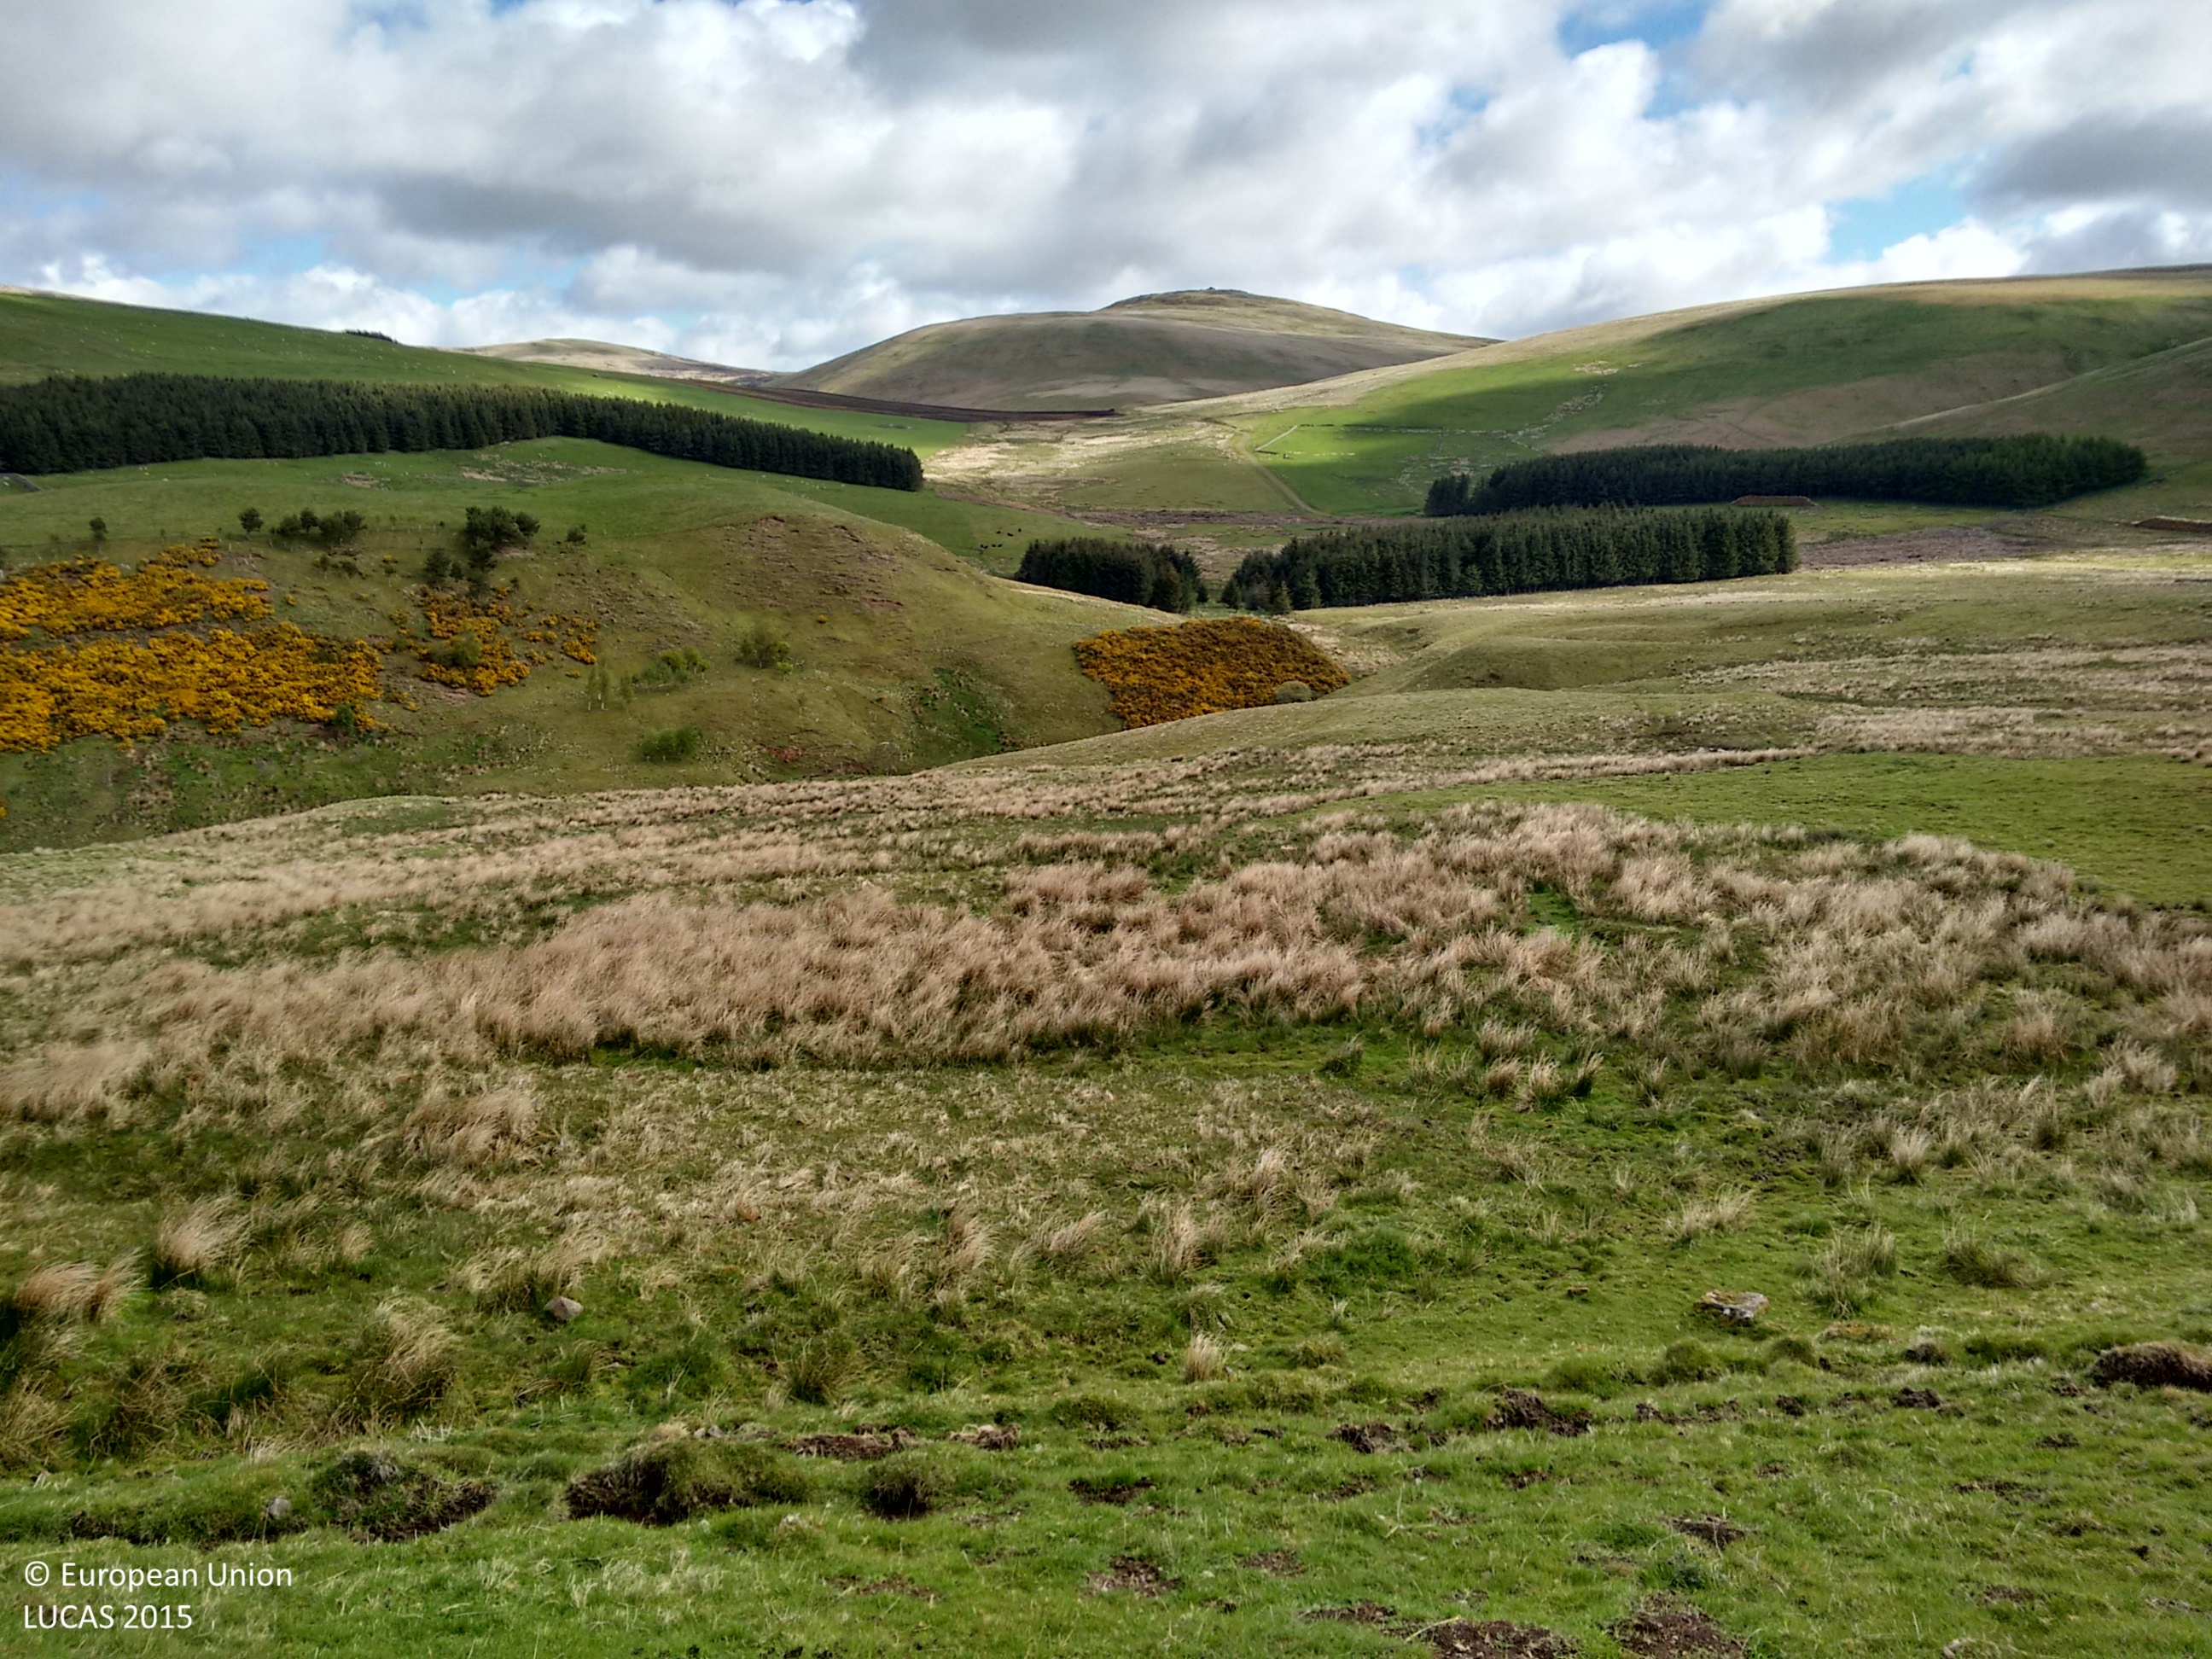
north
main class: Grassland
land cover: Grassland without tree/shrub cover
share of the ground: > 75 %
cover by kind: herbaceous plants 100 %
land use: Agriculture (excluding fallow land and kitchen gardens)
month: May
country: GB
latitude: 55.4734
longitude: -2.2222
